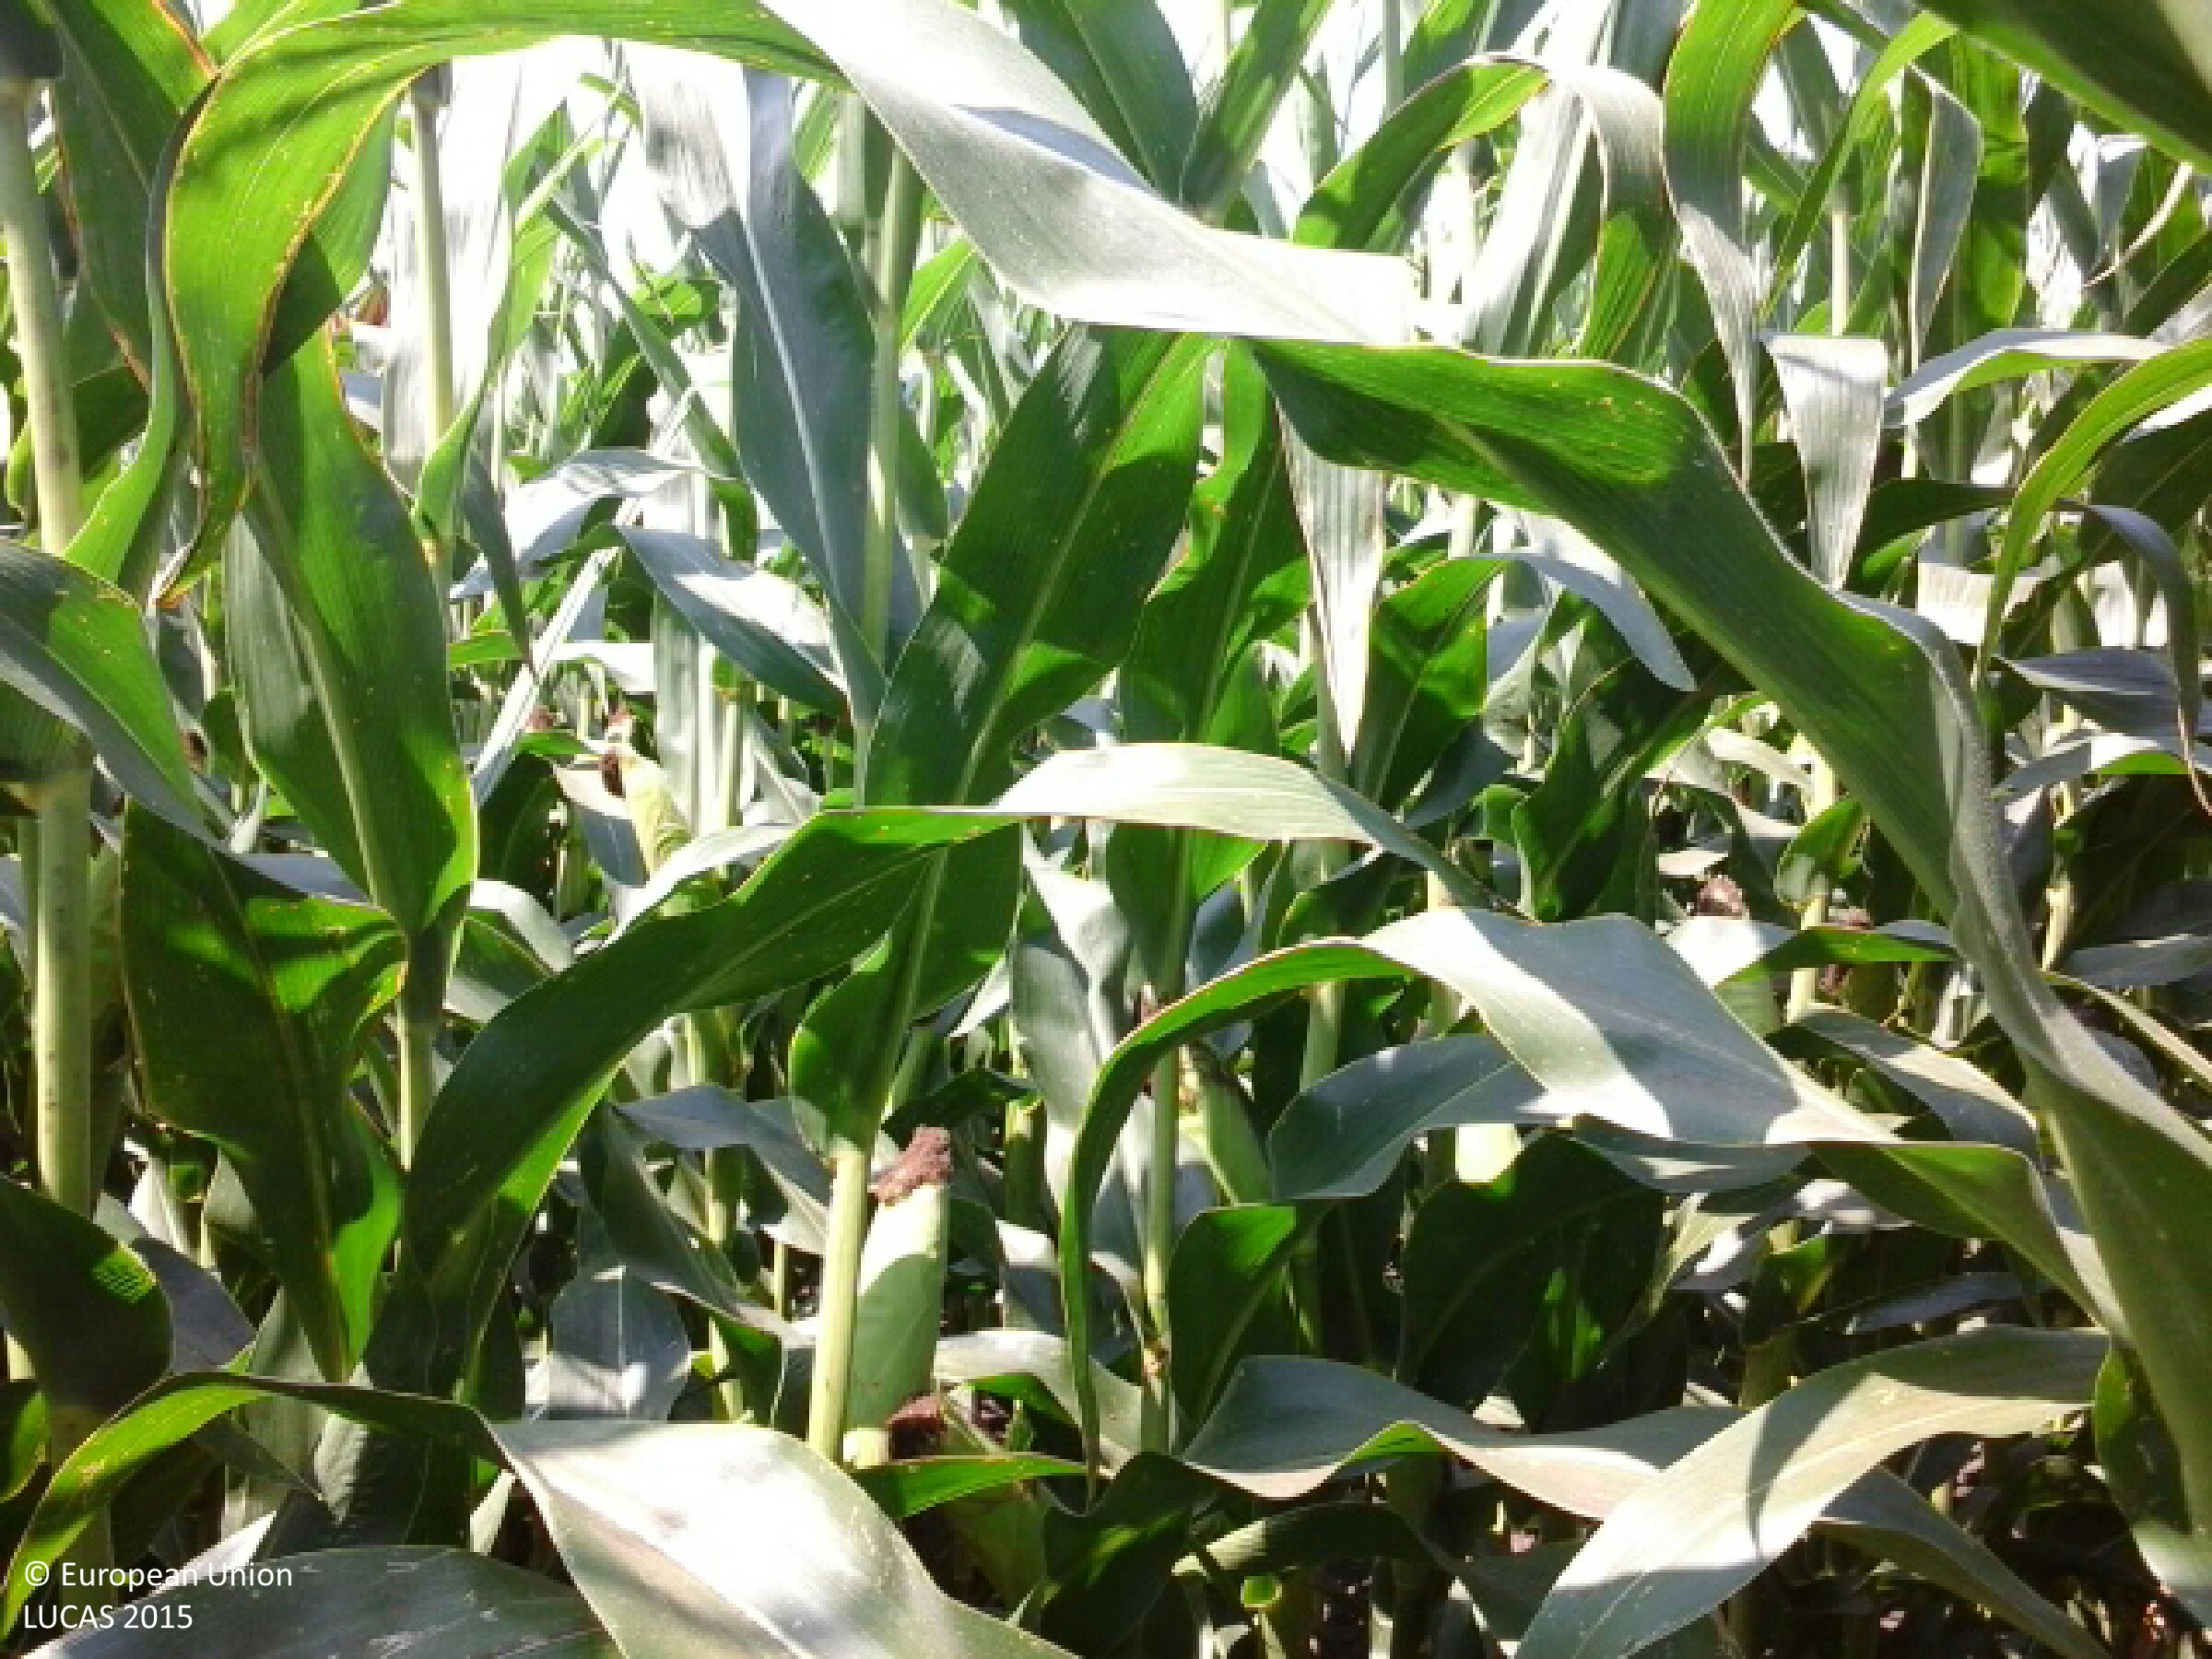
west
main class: Cropland
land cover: Maize
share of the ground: > 75 %
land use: Agriculture (excluding fallow land and kitchen gardens)
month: August
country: HU
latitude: 47.6325
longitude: 18.1436
